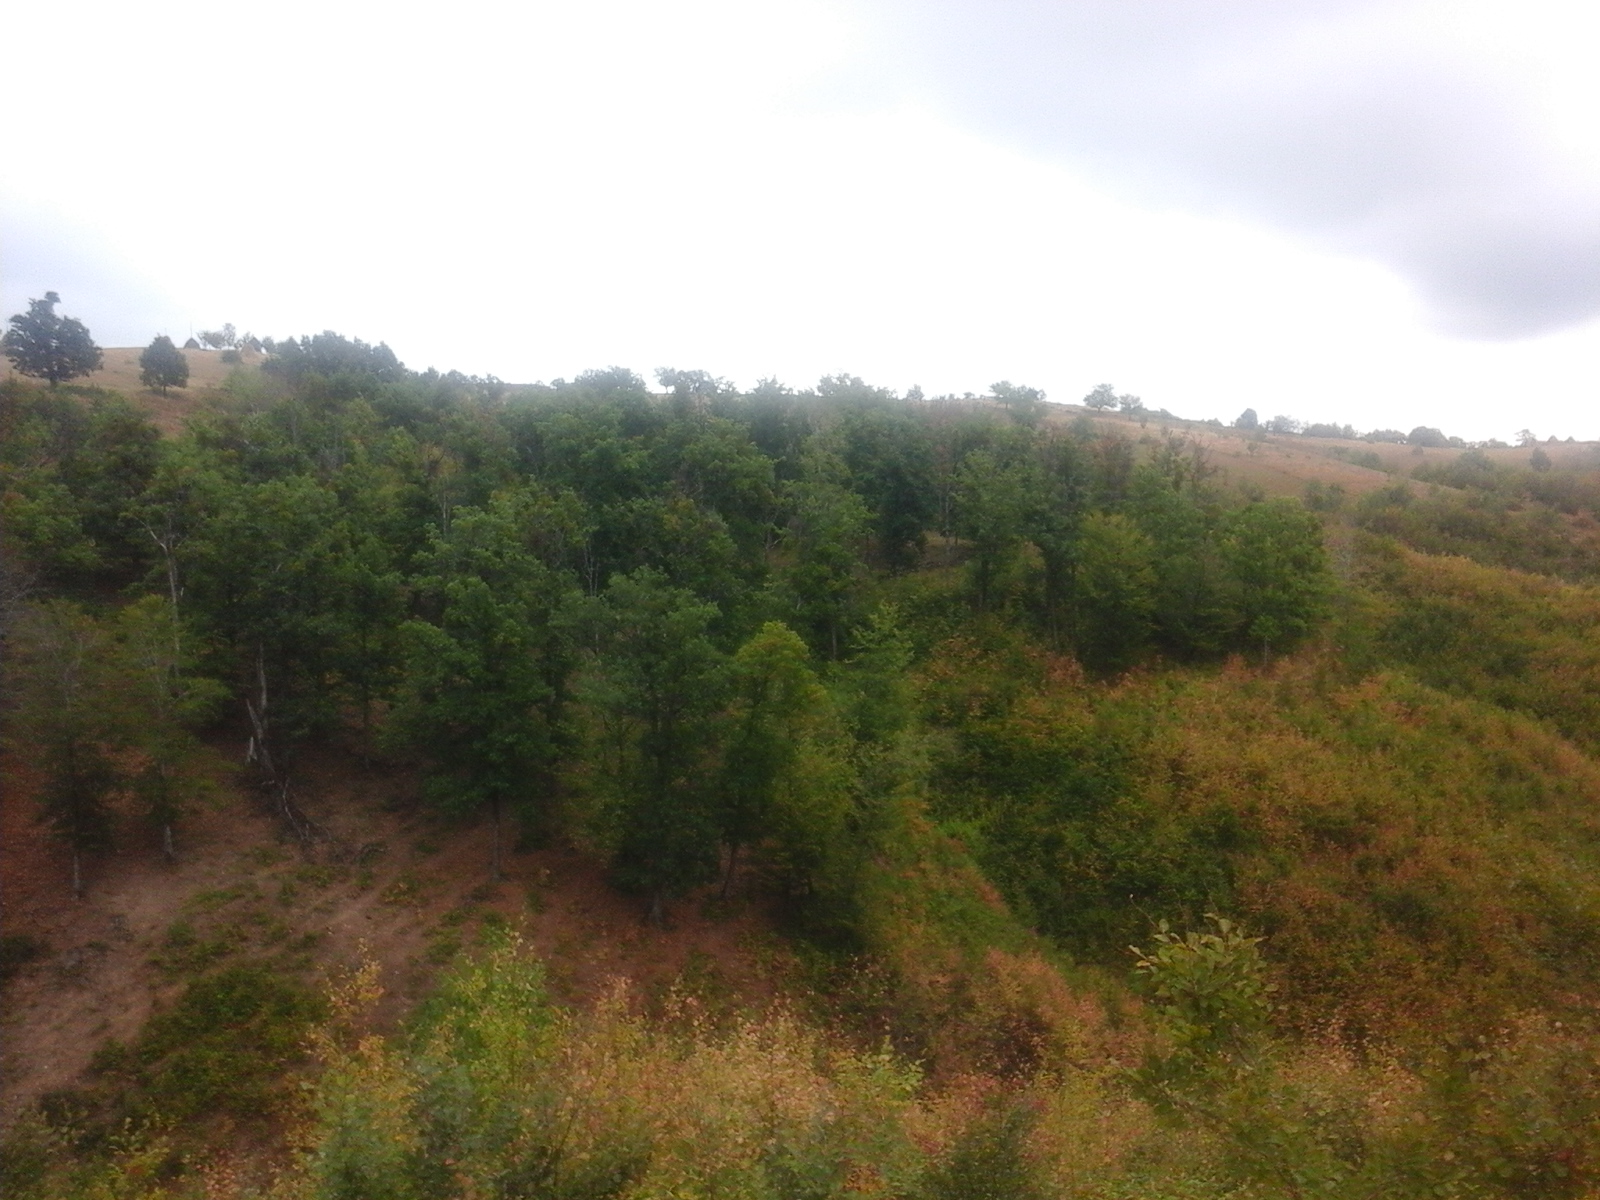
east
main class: Woodland
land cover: Broadleaved woodland
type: acidophilous oak and oak-birch forest
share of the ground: > 75 %
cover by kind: broadleaved forest trees 100 %
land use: Forestry
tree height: > 5 m
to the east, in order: Broadleaved woodland
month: August
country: RO
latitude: 44.9395
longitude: 22.8072
